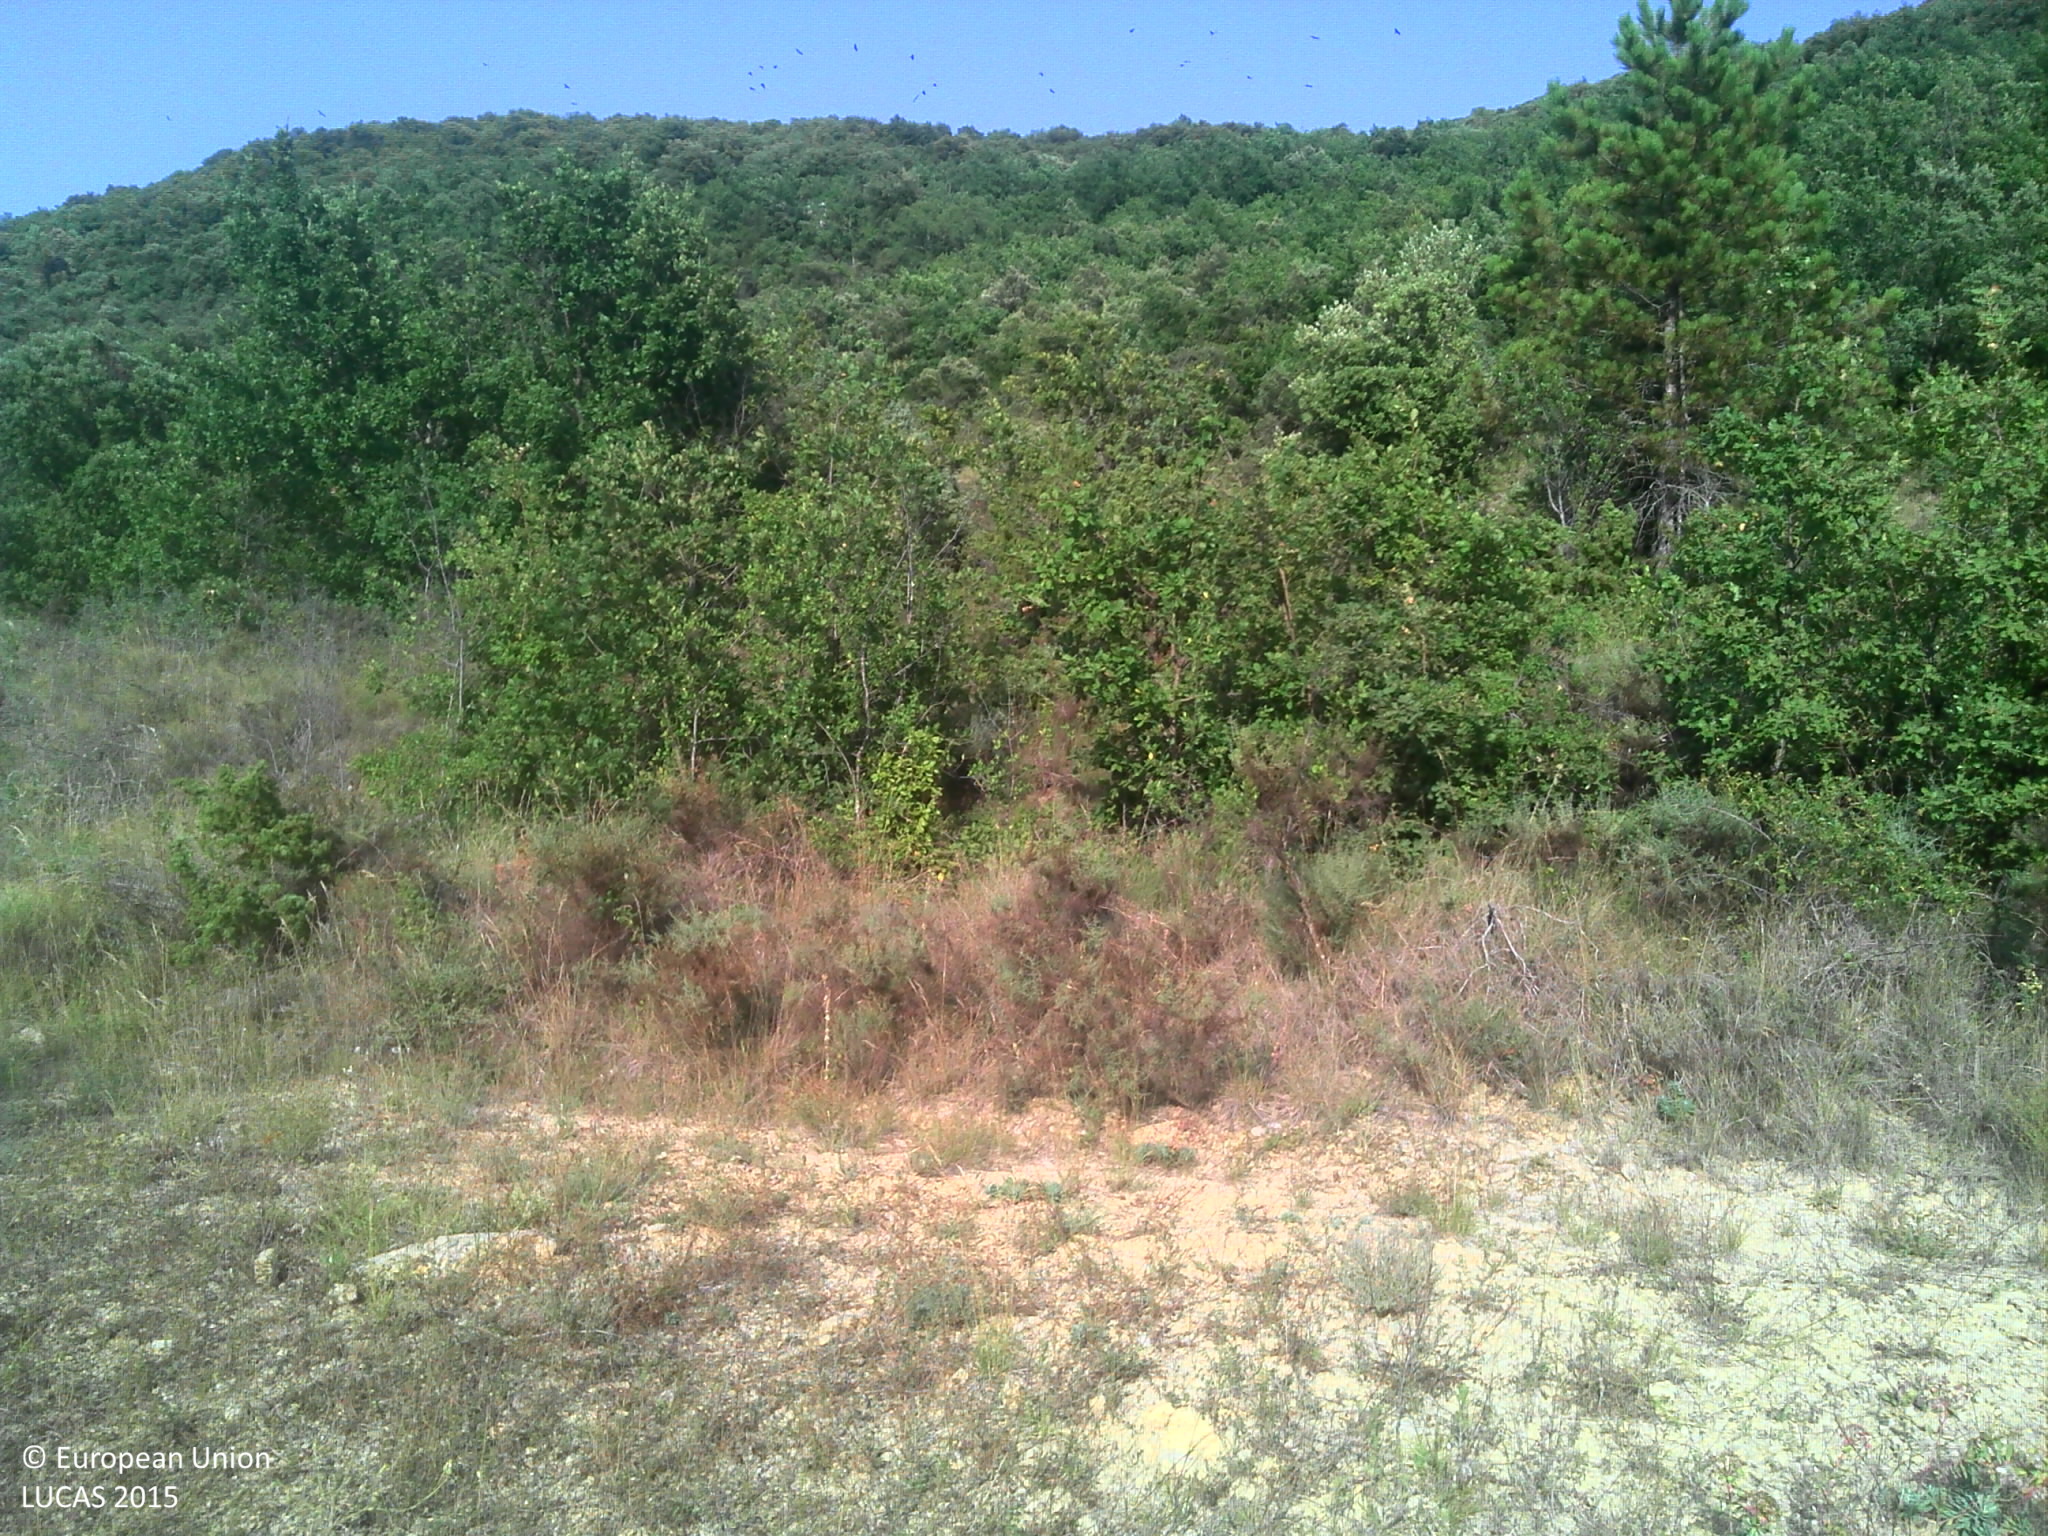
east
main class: Grassland
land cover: Grassland without tree/shrub cover
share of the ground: > 75 %
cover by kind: herbaceous plants 100 %
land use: Semi-natural and natural areas not in use
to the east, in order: Grassland without tree/shrub cover; Shrubland without tree cover; Broadleaved woodland
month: July
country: FR
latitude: 44.3731
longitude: 4.2716
